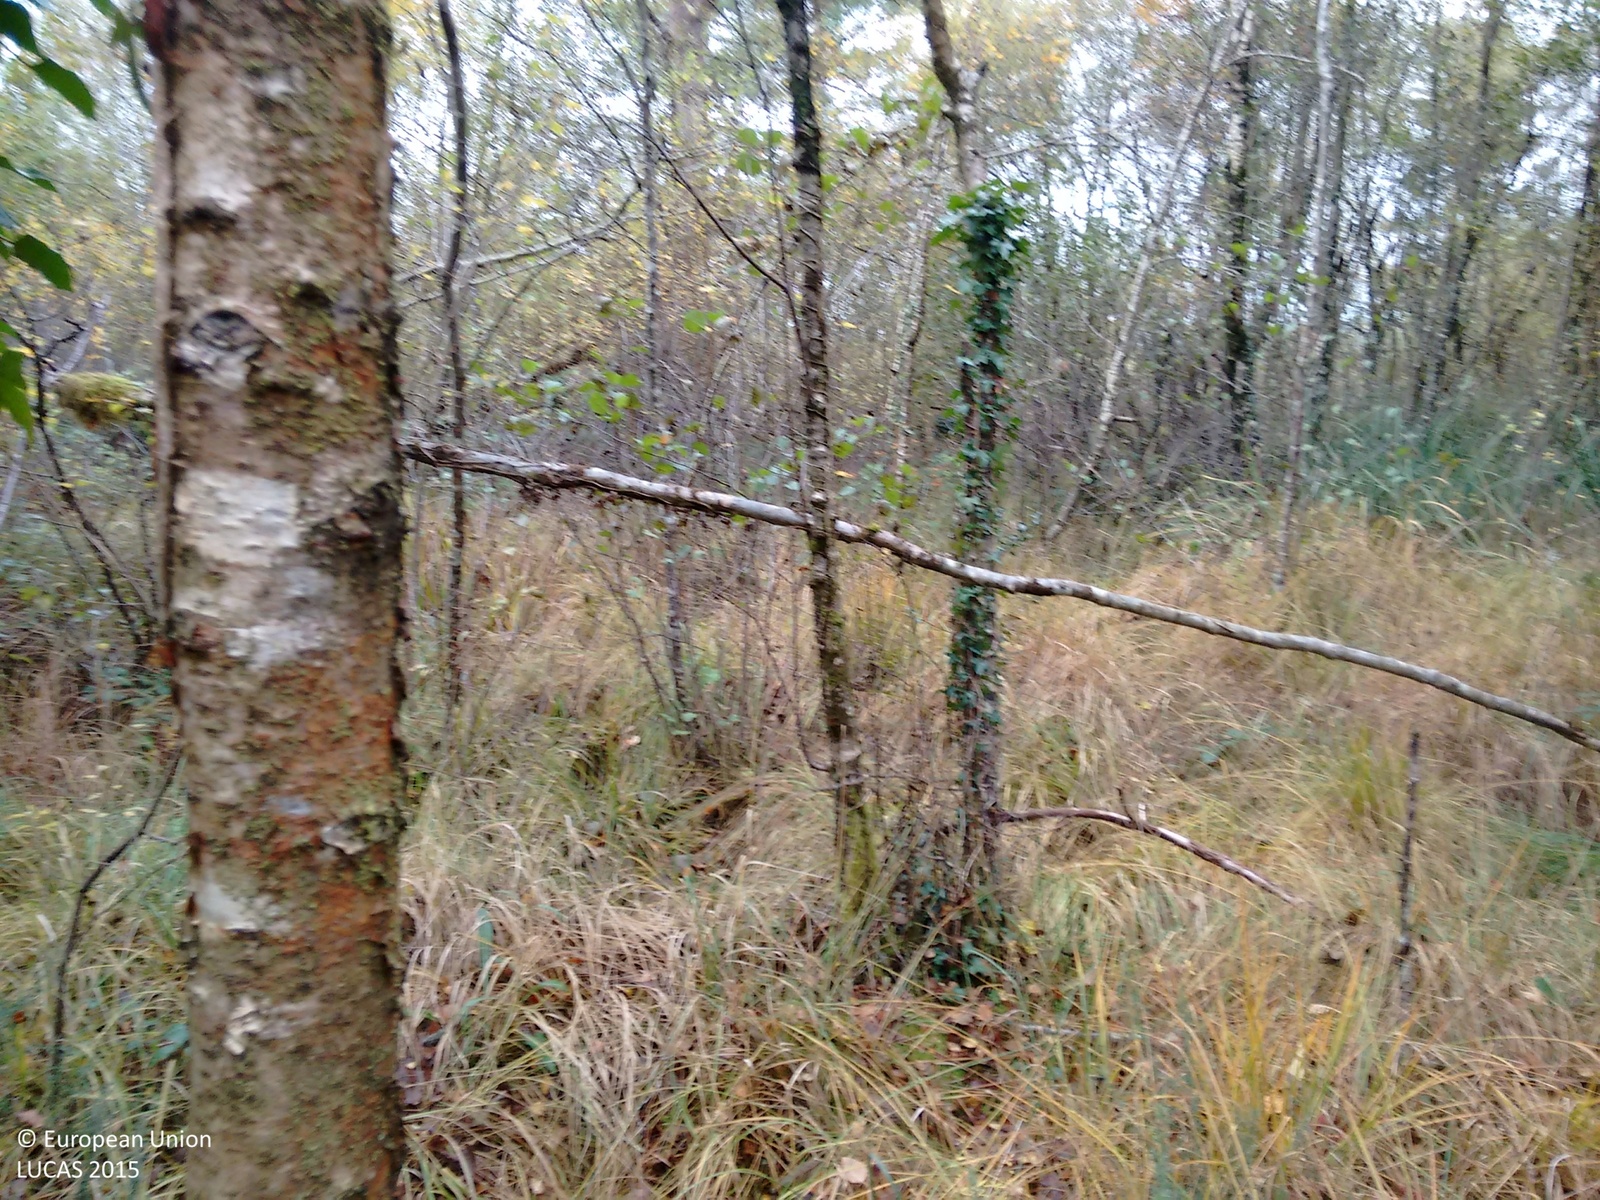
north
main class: Woodland
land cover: Other mixed woodland
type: acidophilous oak and oak-birch forest
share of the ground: > 75 %
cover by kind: broadleaved forest trees 60 %, coniferous forest trees 40 %
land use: Semi-natural and natural areas not in use
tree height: > 5 m
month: October
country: IE
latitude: 53.2248
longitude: -7.5812
